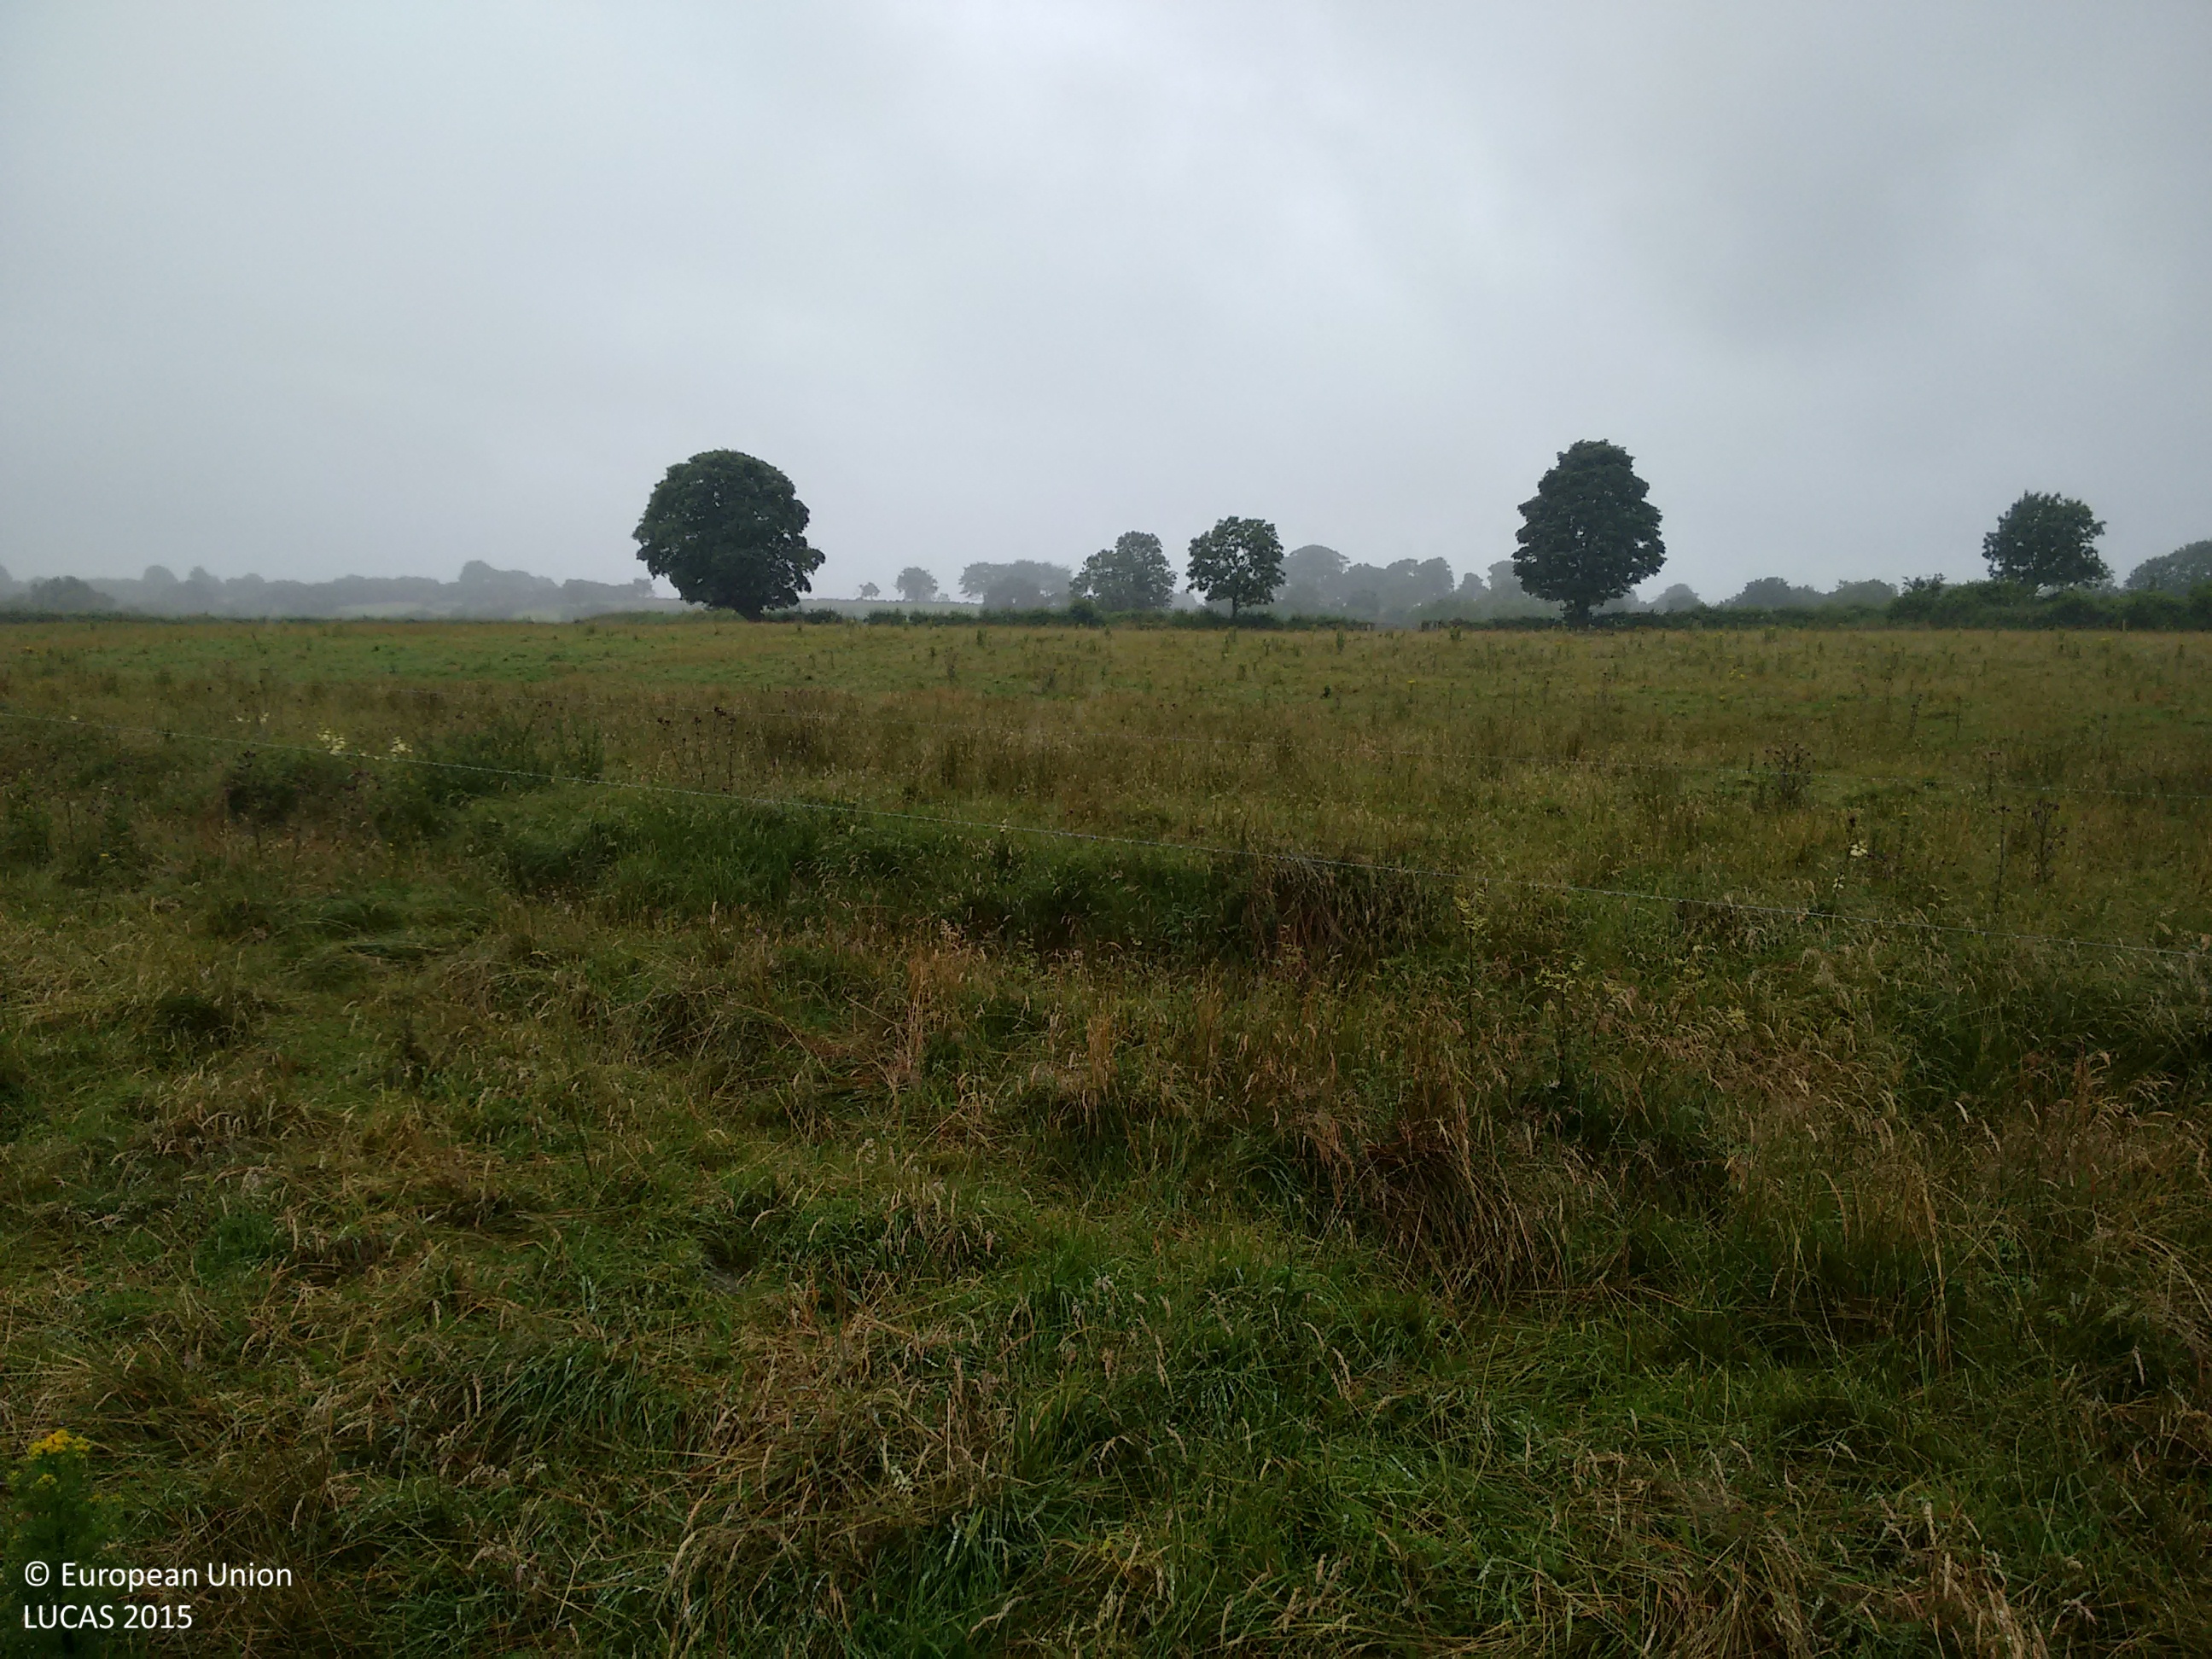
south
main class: Grassland
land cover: Grassland without tree/shrub cover
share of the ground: > 75 %
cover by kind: herbaceous plants 95 %, shrubs 5 %
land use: Agriculture (excluding fallow land and kitchen gardens)
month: July
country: IE
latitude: 53.6672
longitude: -7.8316
